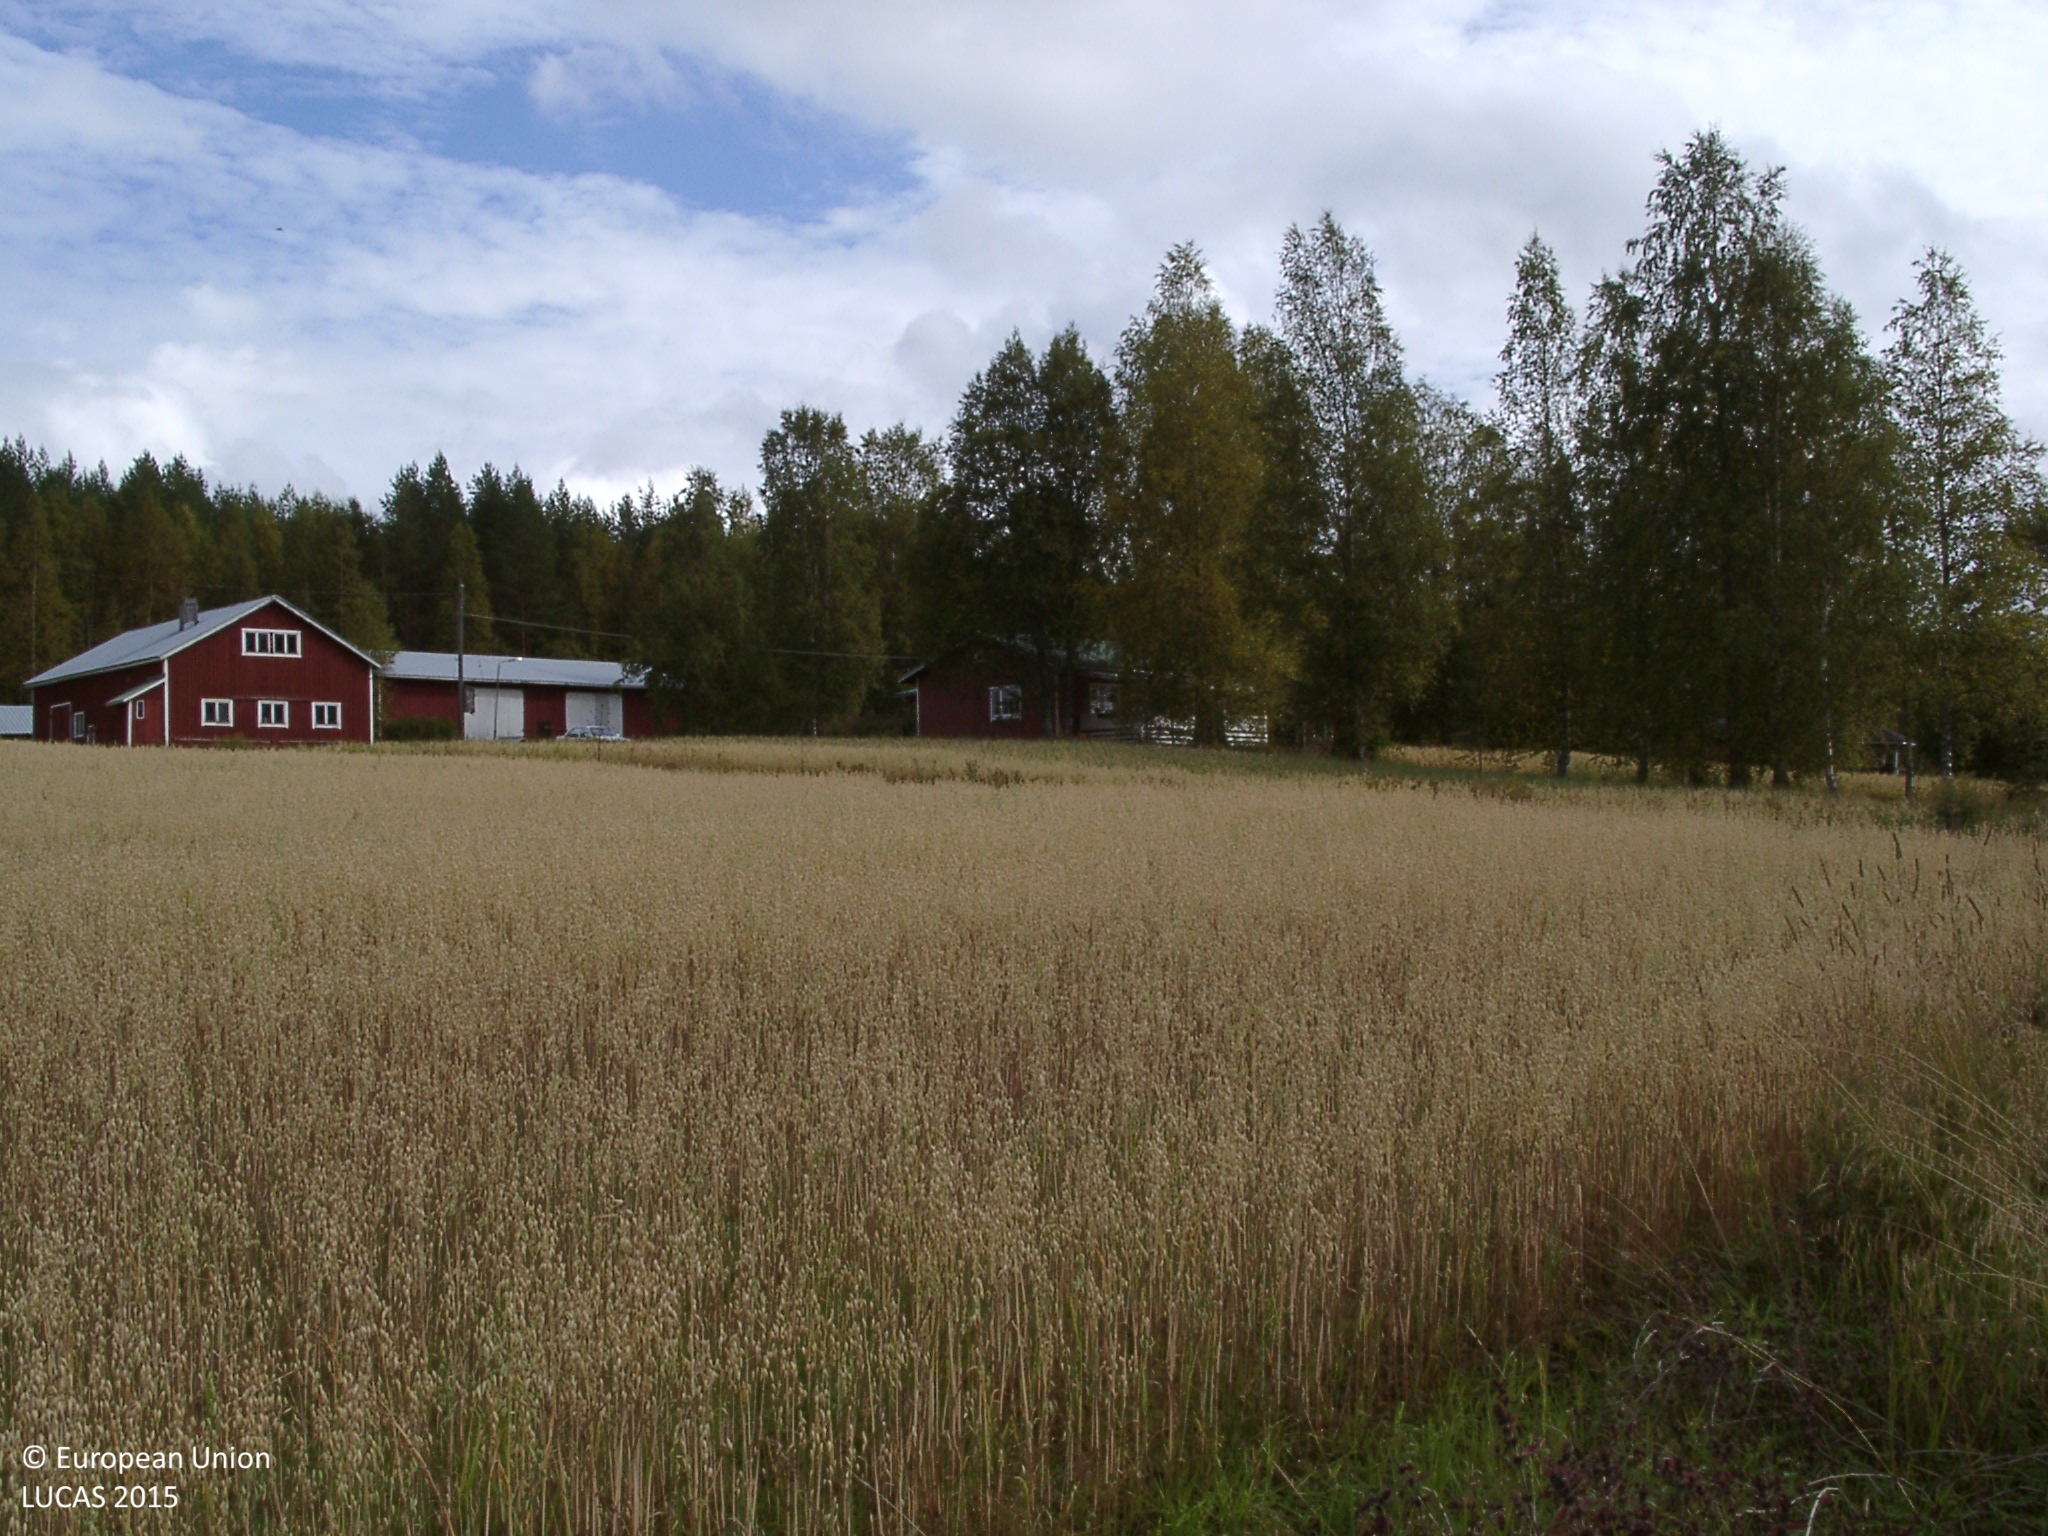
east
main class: Cropland
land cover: Oats
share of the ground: > 75 %
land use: Agriculture (excluding fallow land and kitchen gardens)
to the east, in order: Grass margins; Oats; Grass margins; Ditches and canals; Grass margins; Oats; Artificial constructions in urban areas; Pine dominated mixed woodland; Other mixed woodland
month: September
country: FI
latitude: 62.6369
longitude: 25.0981
